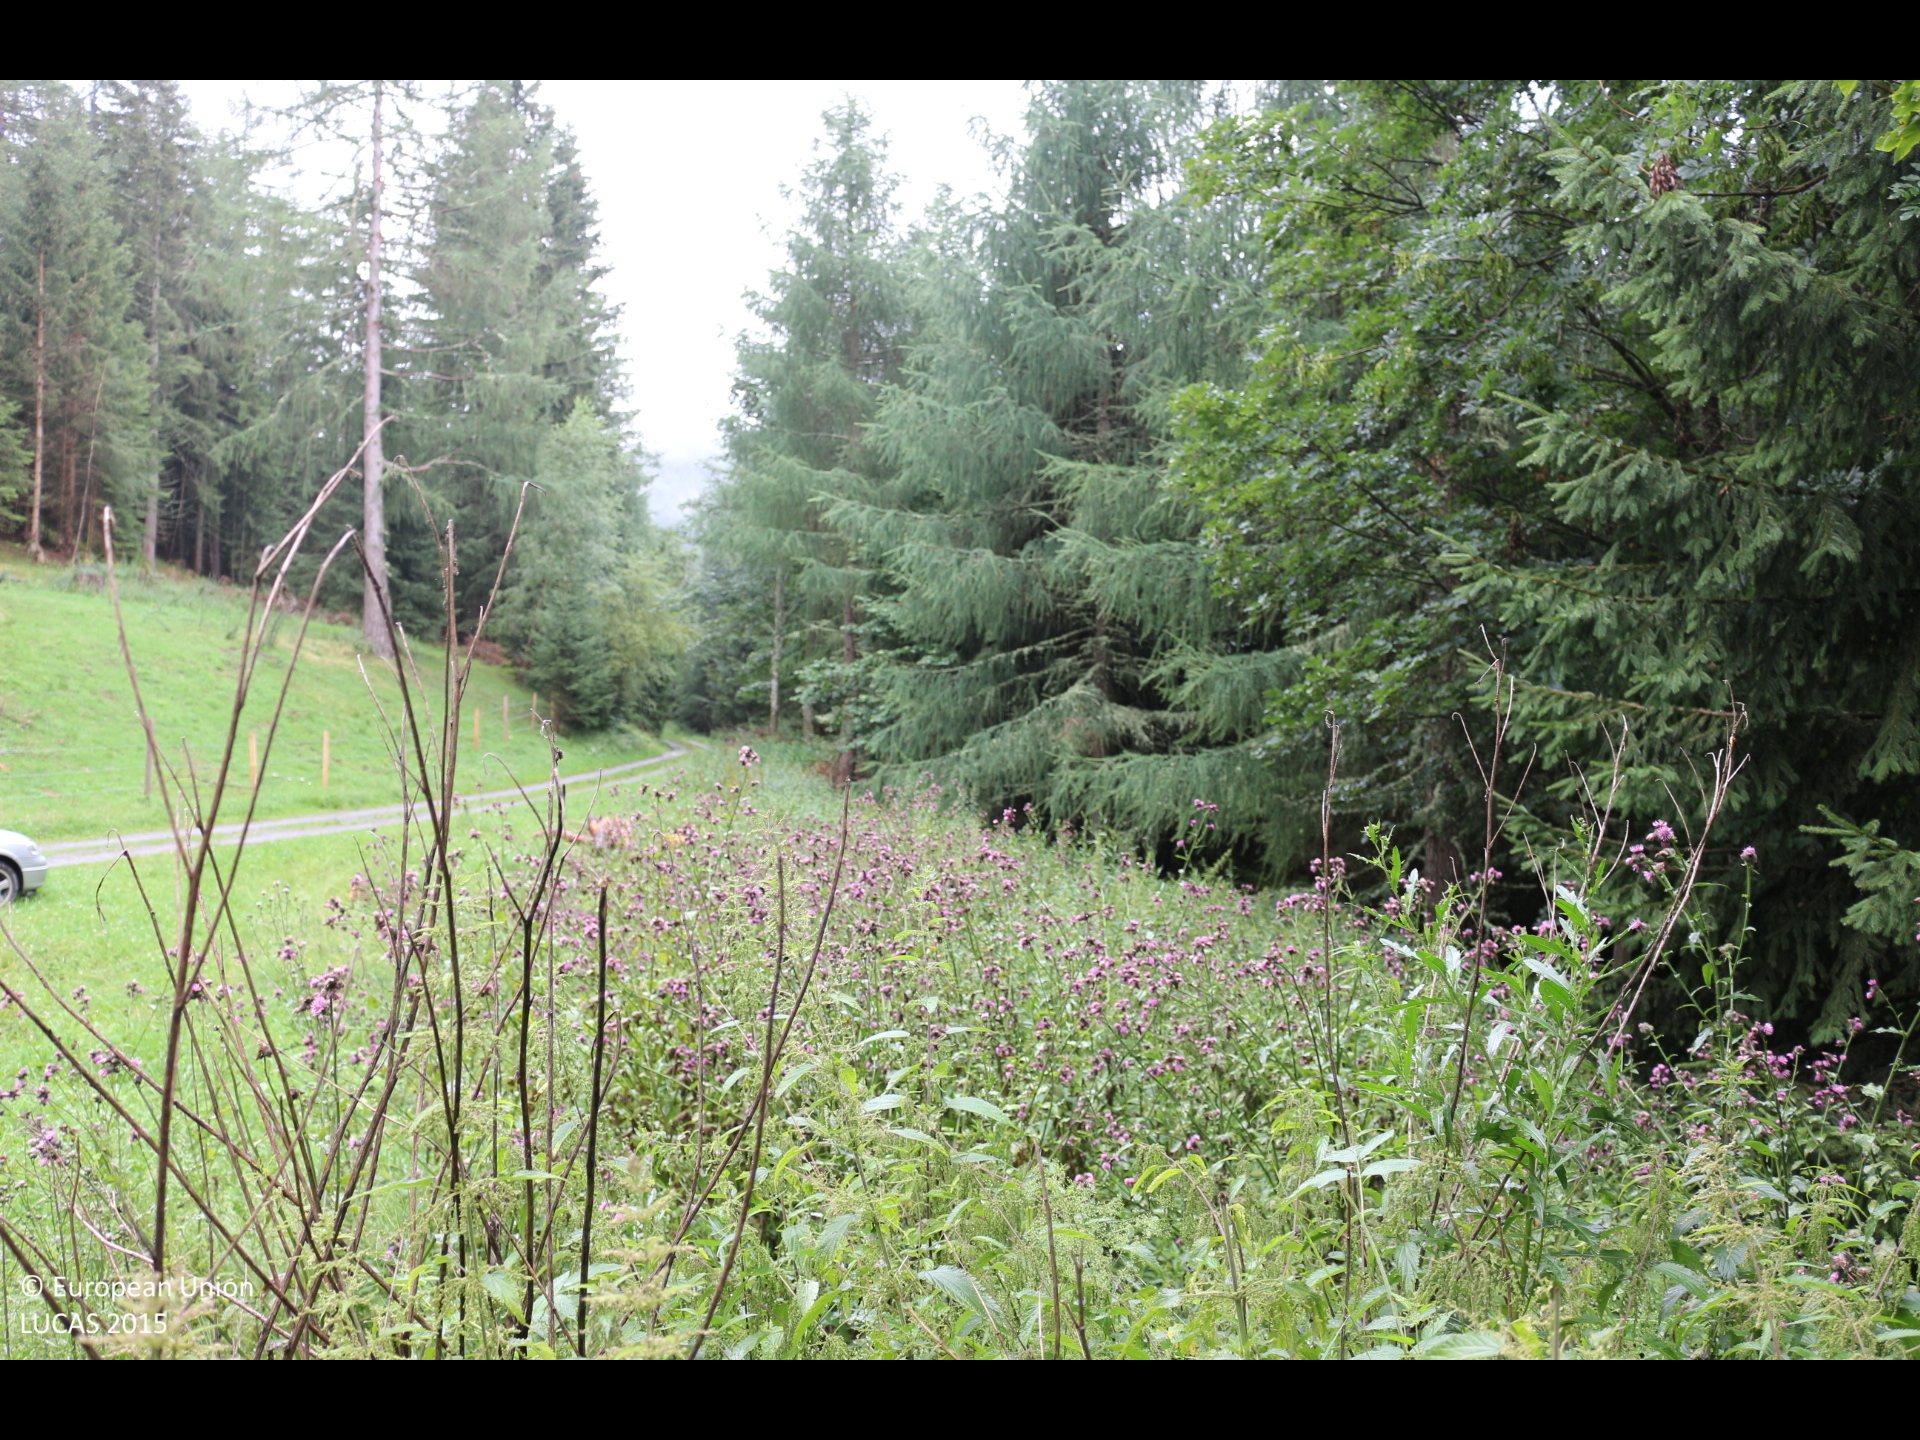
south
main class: Grassland
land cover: Spontaneously vegetated surfaces
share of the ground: > 75 %
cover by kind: herbaceous plants 95 %, shrubs 5 %
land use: Semi-natural and natural areas not in use
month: July
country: AT
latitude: 46.9703
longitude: 14.2435
